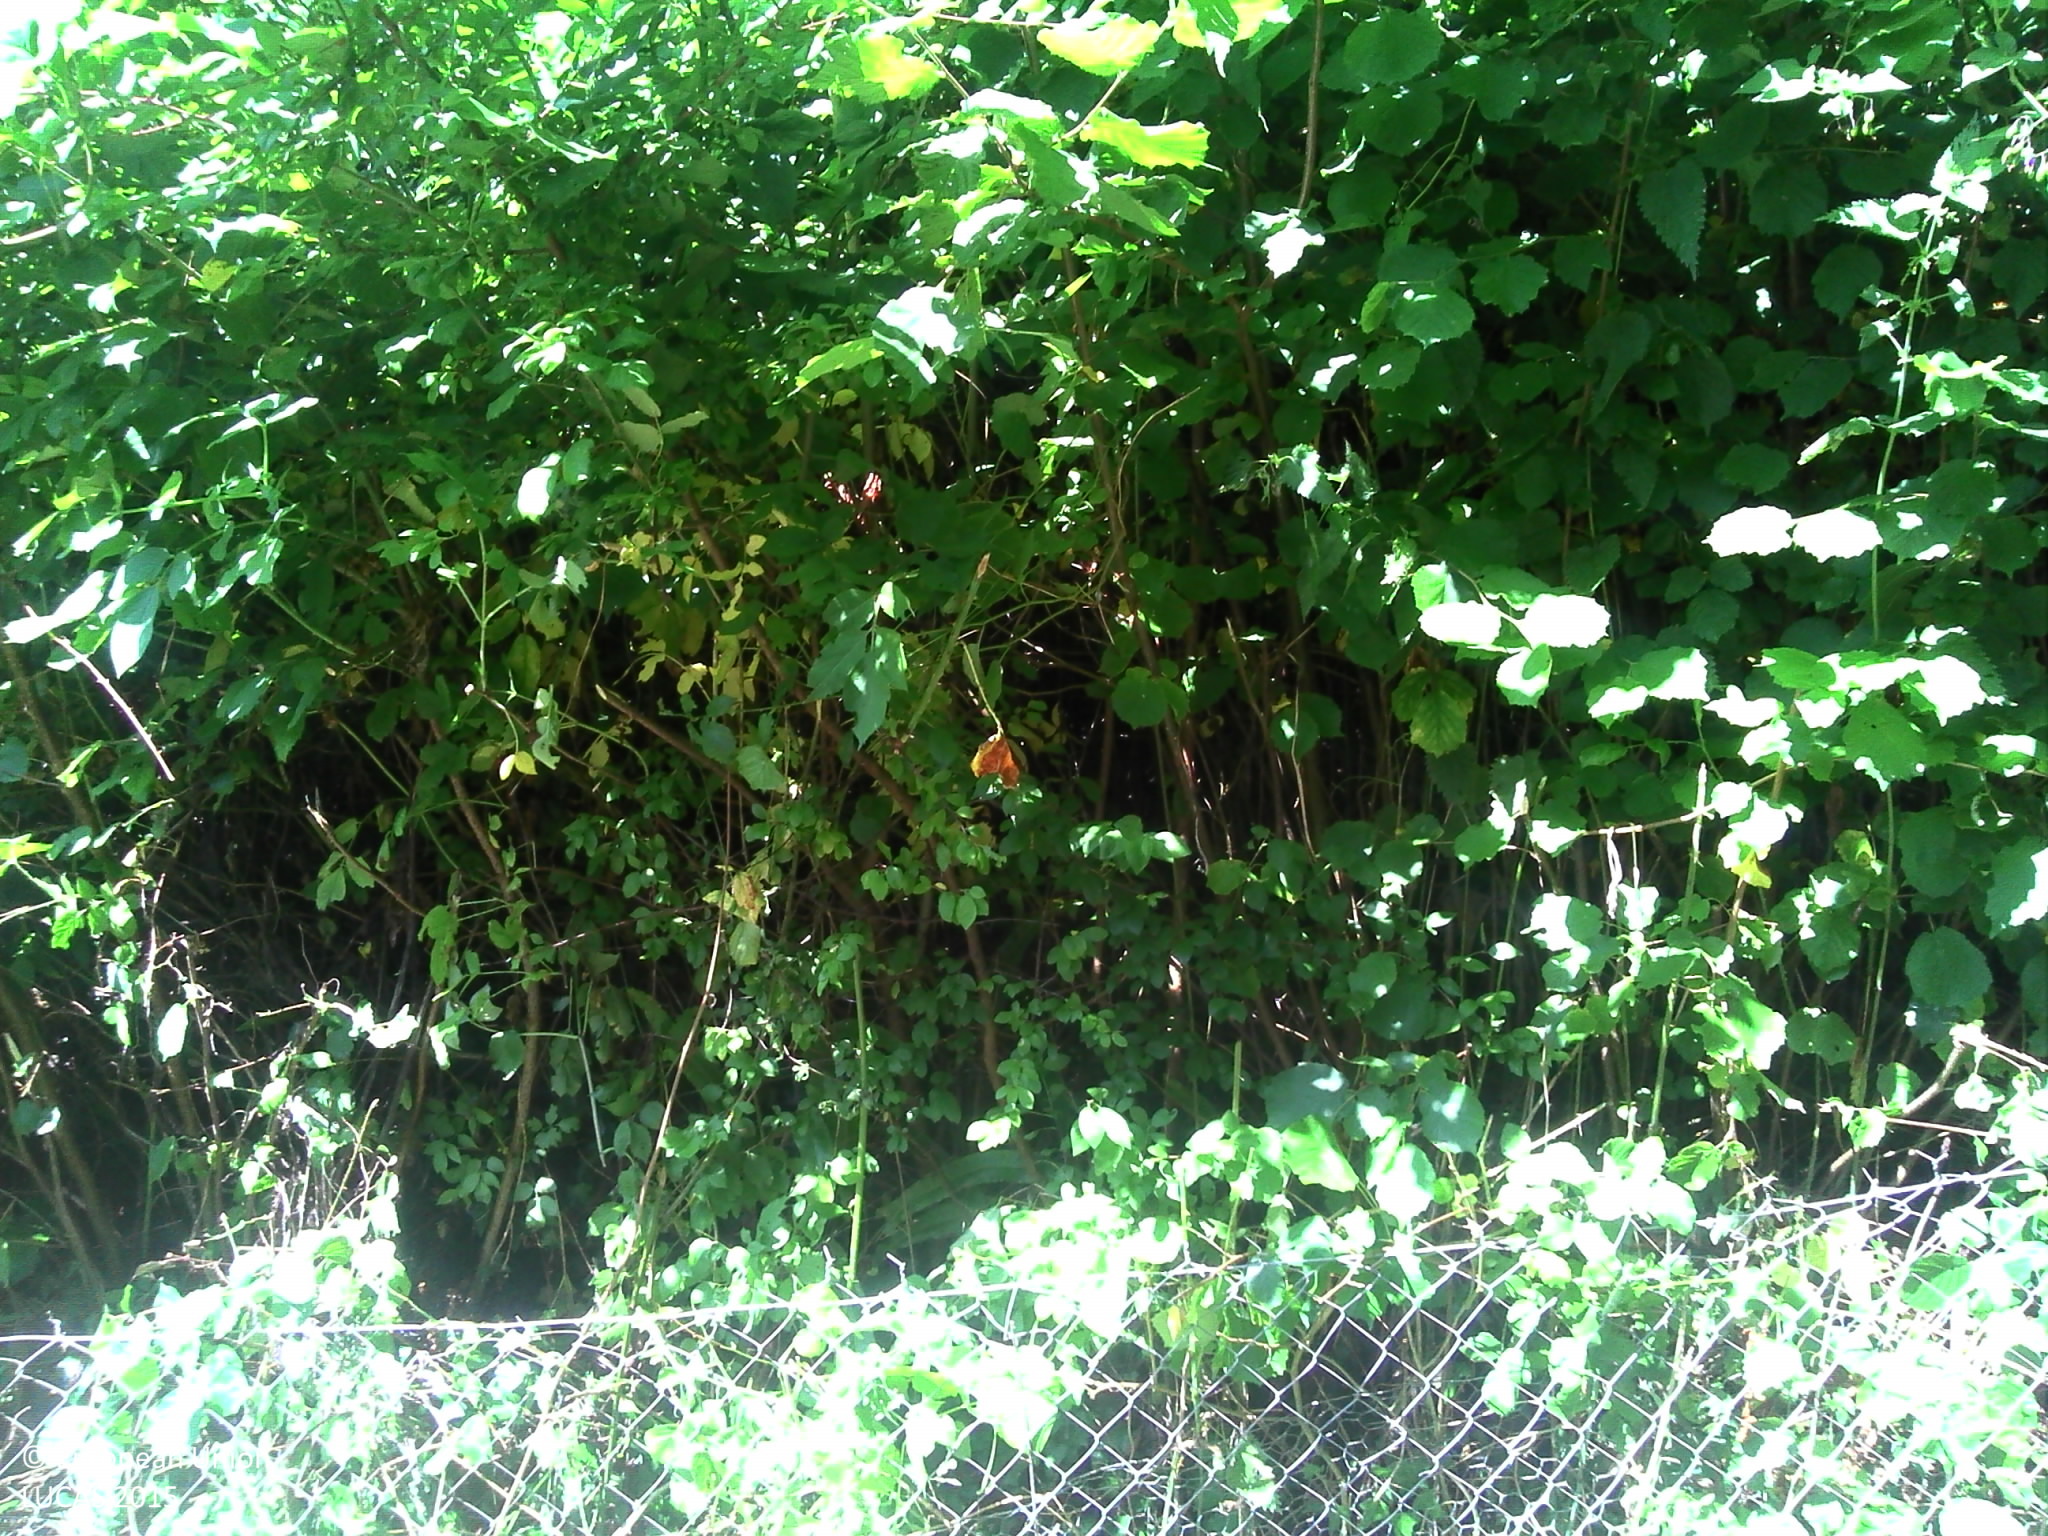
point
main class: Woodland
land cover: Broadleaved woodland
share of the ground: > 75 %
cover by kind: broadleaved forest trees 90 %, shrubs 10 %
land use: Forestry
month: July
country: FR
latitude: 49.0100
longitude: -1.4083
